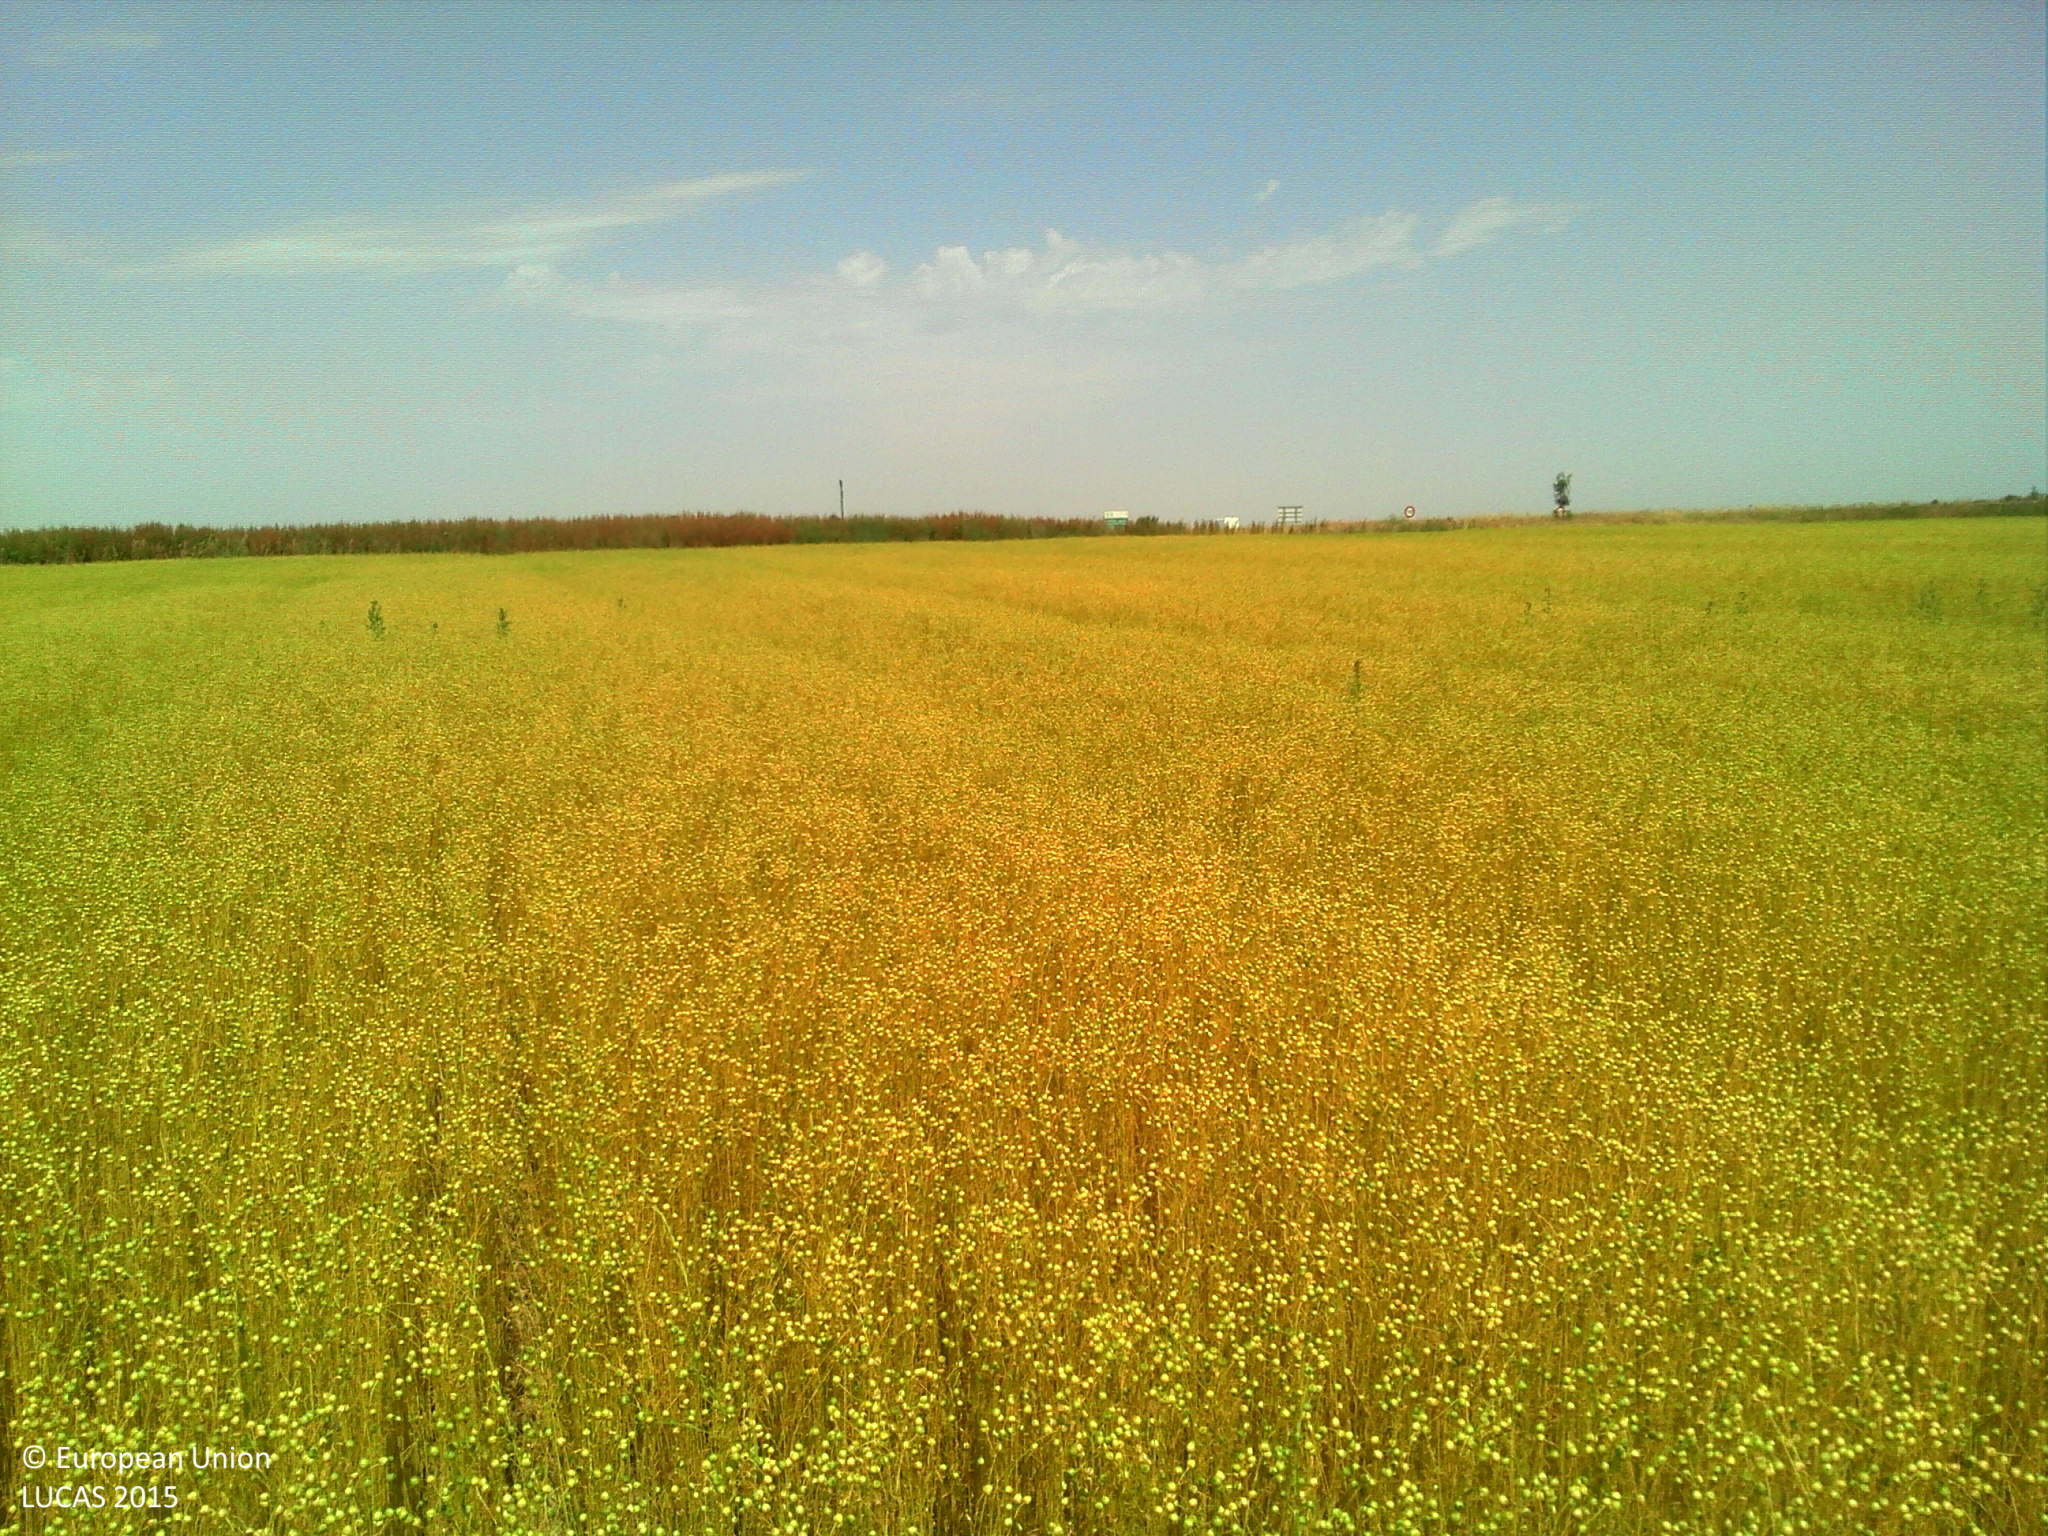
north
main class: Cropland
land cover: Other fibre and oleaginous crops
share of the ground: > 75 %
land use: Agriculture (excluding fallow land and kitchen gardens)
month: July
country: FR
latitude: 48.9568
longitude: 1.1986
